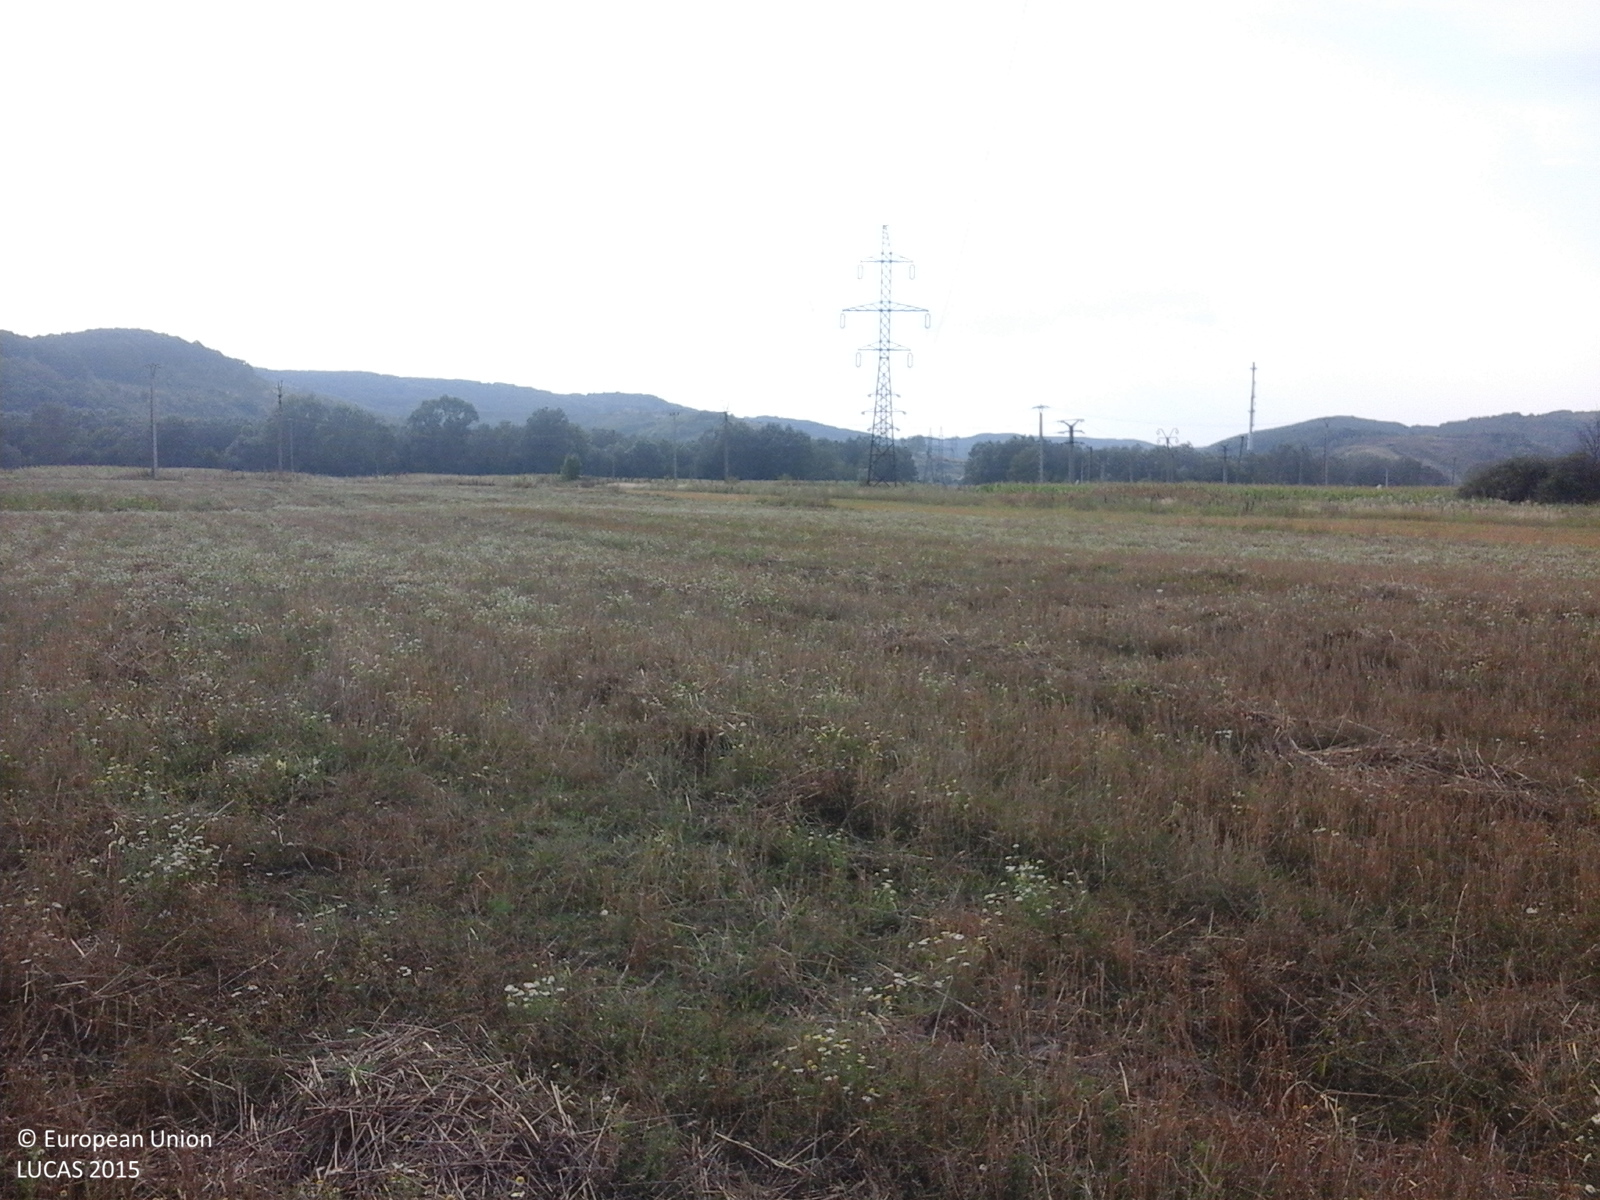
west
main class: Cropland
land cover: Common wheat
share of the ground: > 75 %
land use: Agriculture (excluding fallow land and kitchen gardens)
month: August
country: RO
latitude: 44.7252
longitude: 23.6299
